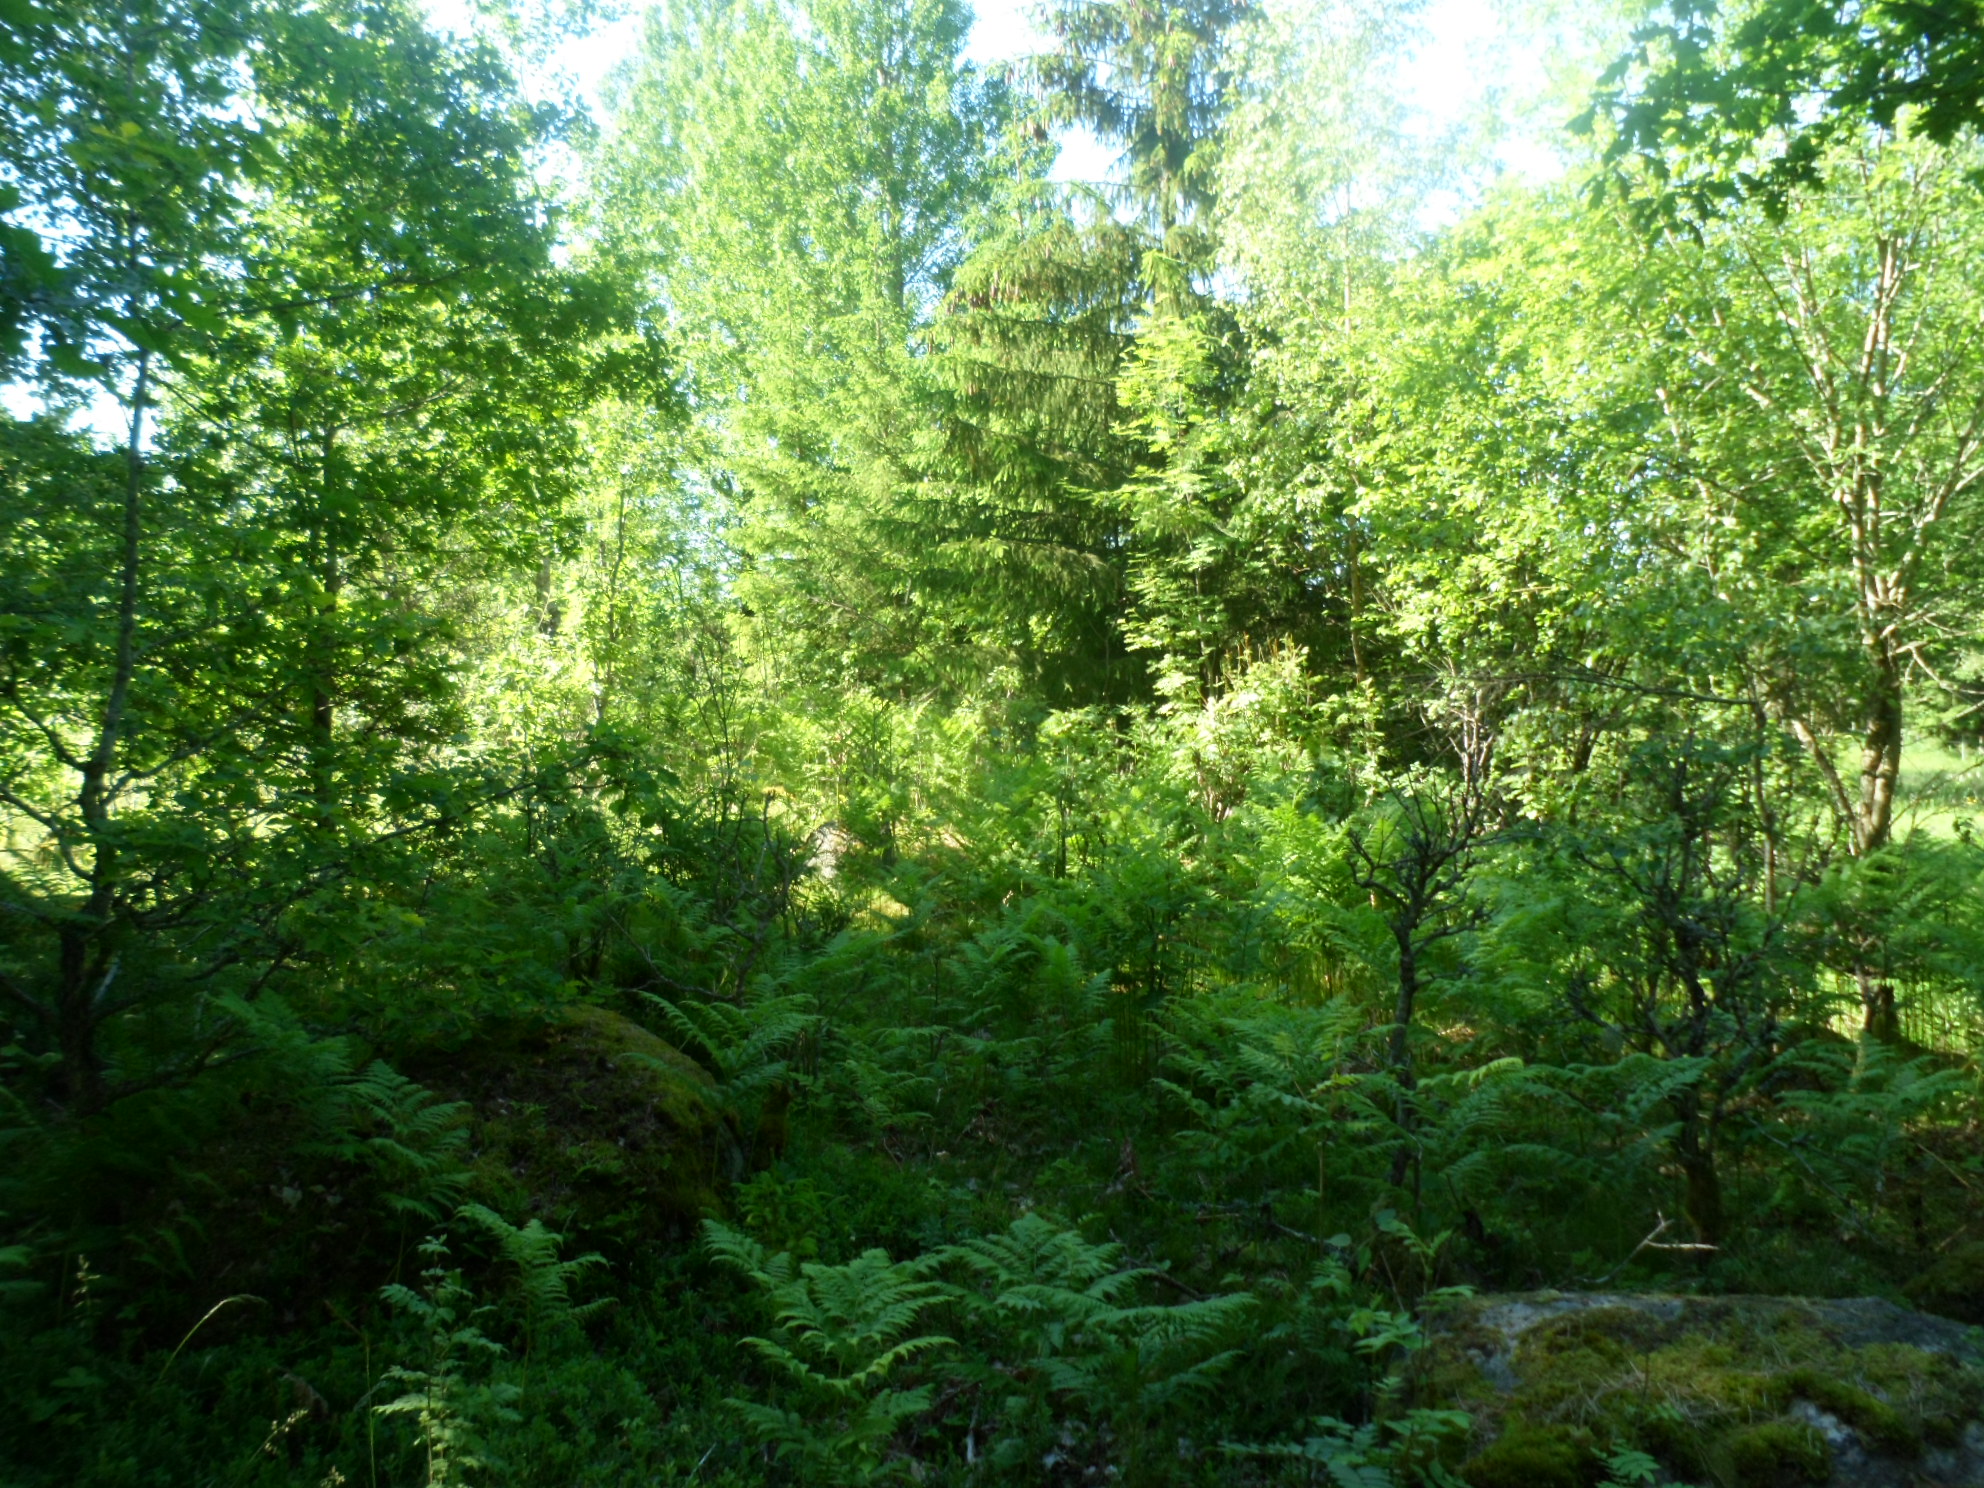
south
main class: Woodland
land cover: Pine dominated mixed woodland
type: boreal forest
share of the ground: 50 - 75 %
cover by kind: coniferous forest trees 30 %, broadleaved forest trees 30 %, herbaceous plants 20 %, shrubs 10 %, lichens and mosses 10 %
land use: Forestry
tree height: > 5 m
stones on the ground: 25 - 50 %
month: July
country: SE
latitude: 57.3157
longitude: 14.4956
